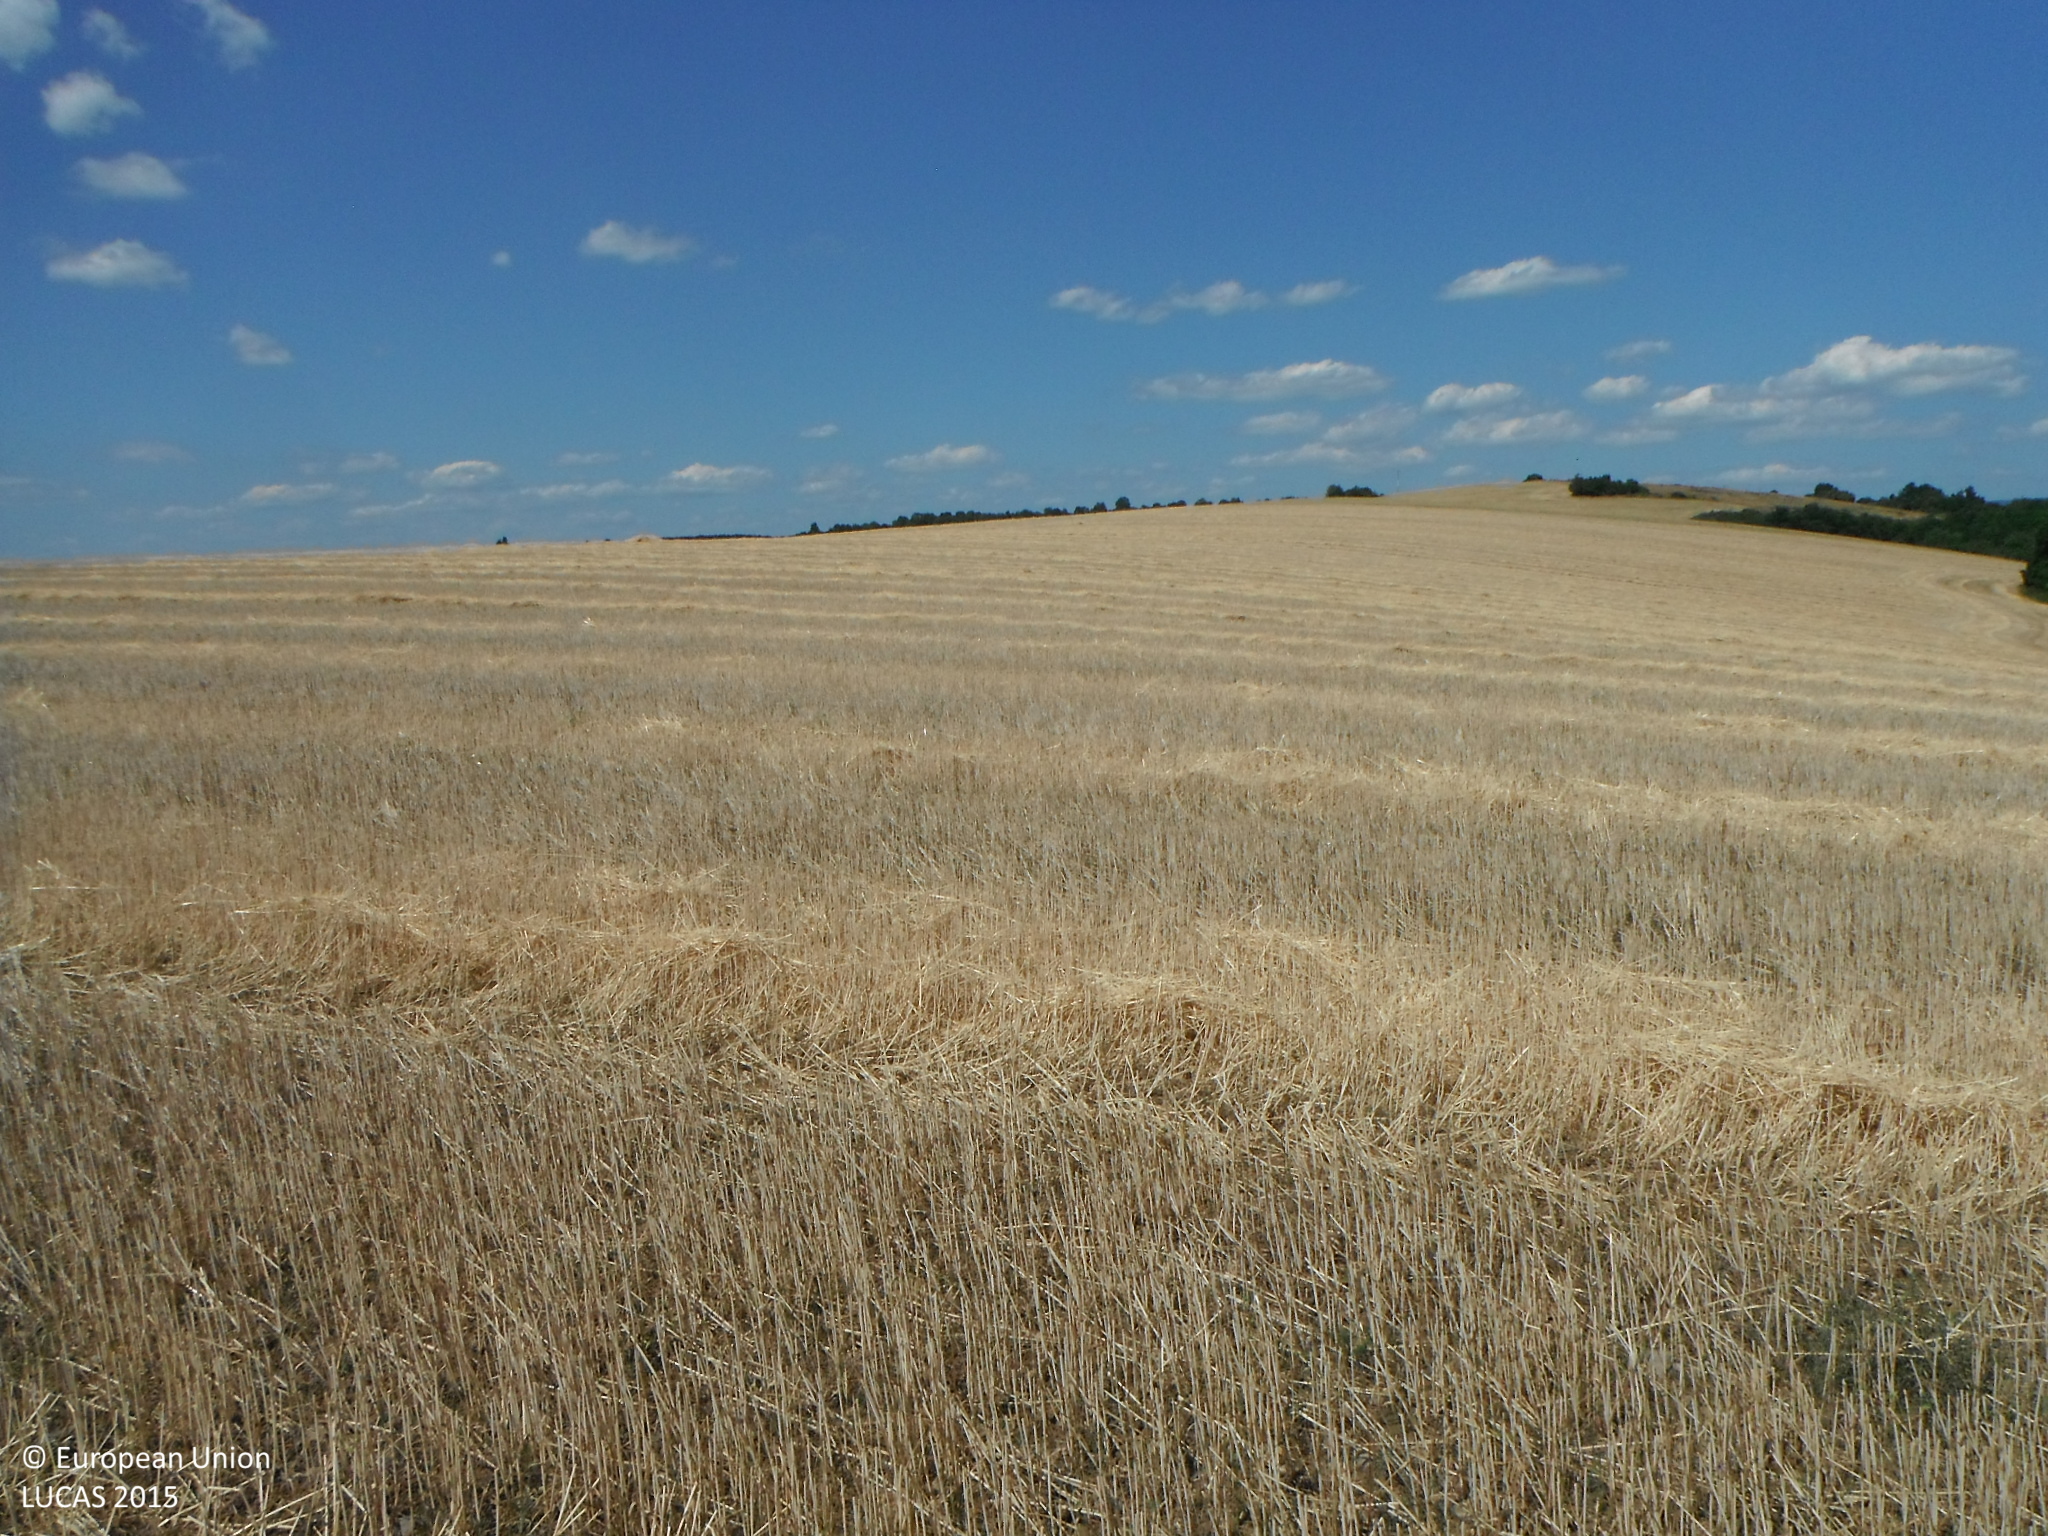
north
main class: Cropland
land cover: Common wheat
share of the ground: > 75 %
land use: Agriculture (excluding fallow land and kitchen gardens)
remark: Harvested field
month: July
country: SK
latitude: 48.3109
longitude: 19.1769
